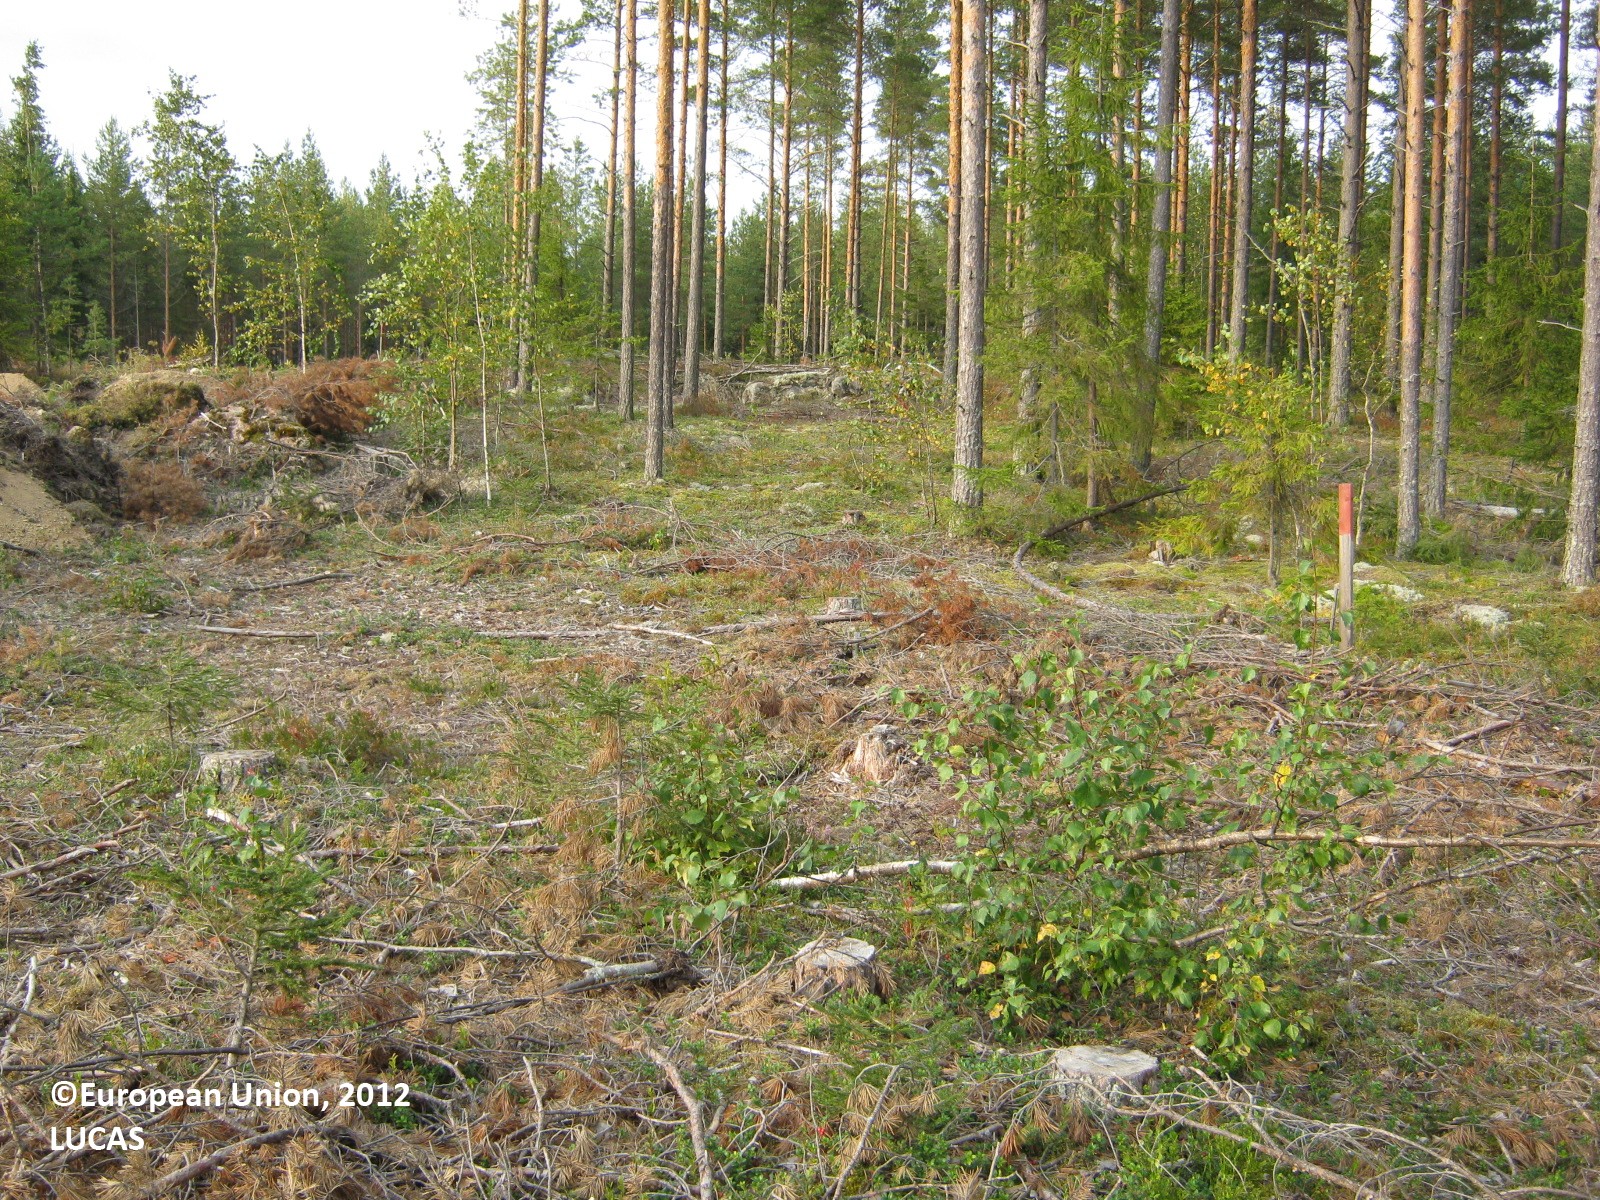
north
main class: Shrubland
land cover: Shrubland with sparse tree cover
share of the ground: > 75 %
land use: Forestry
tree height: < 5 m
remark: Clear cut
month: September
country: FI
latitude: 60.7568
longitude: 28.0965
